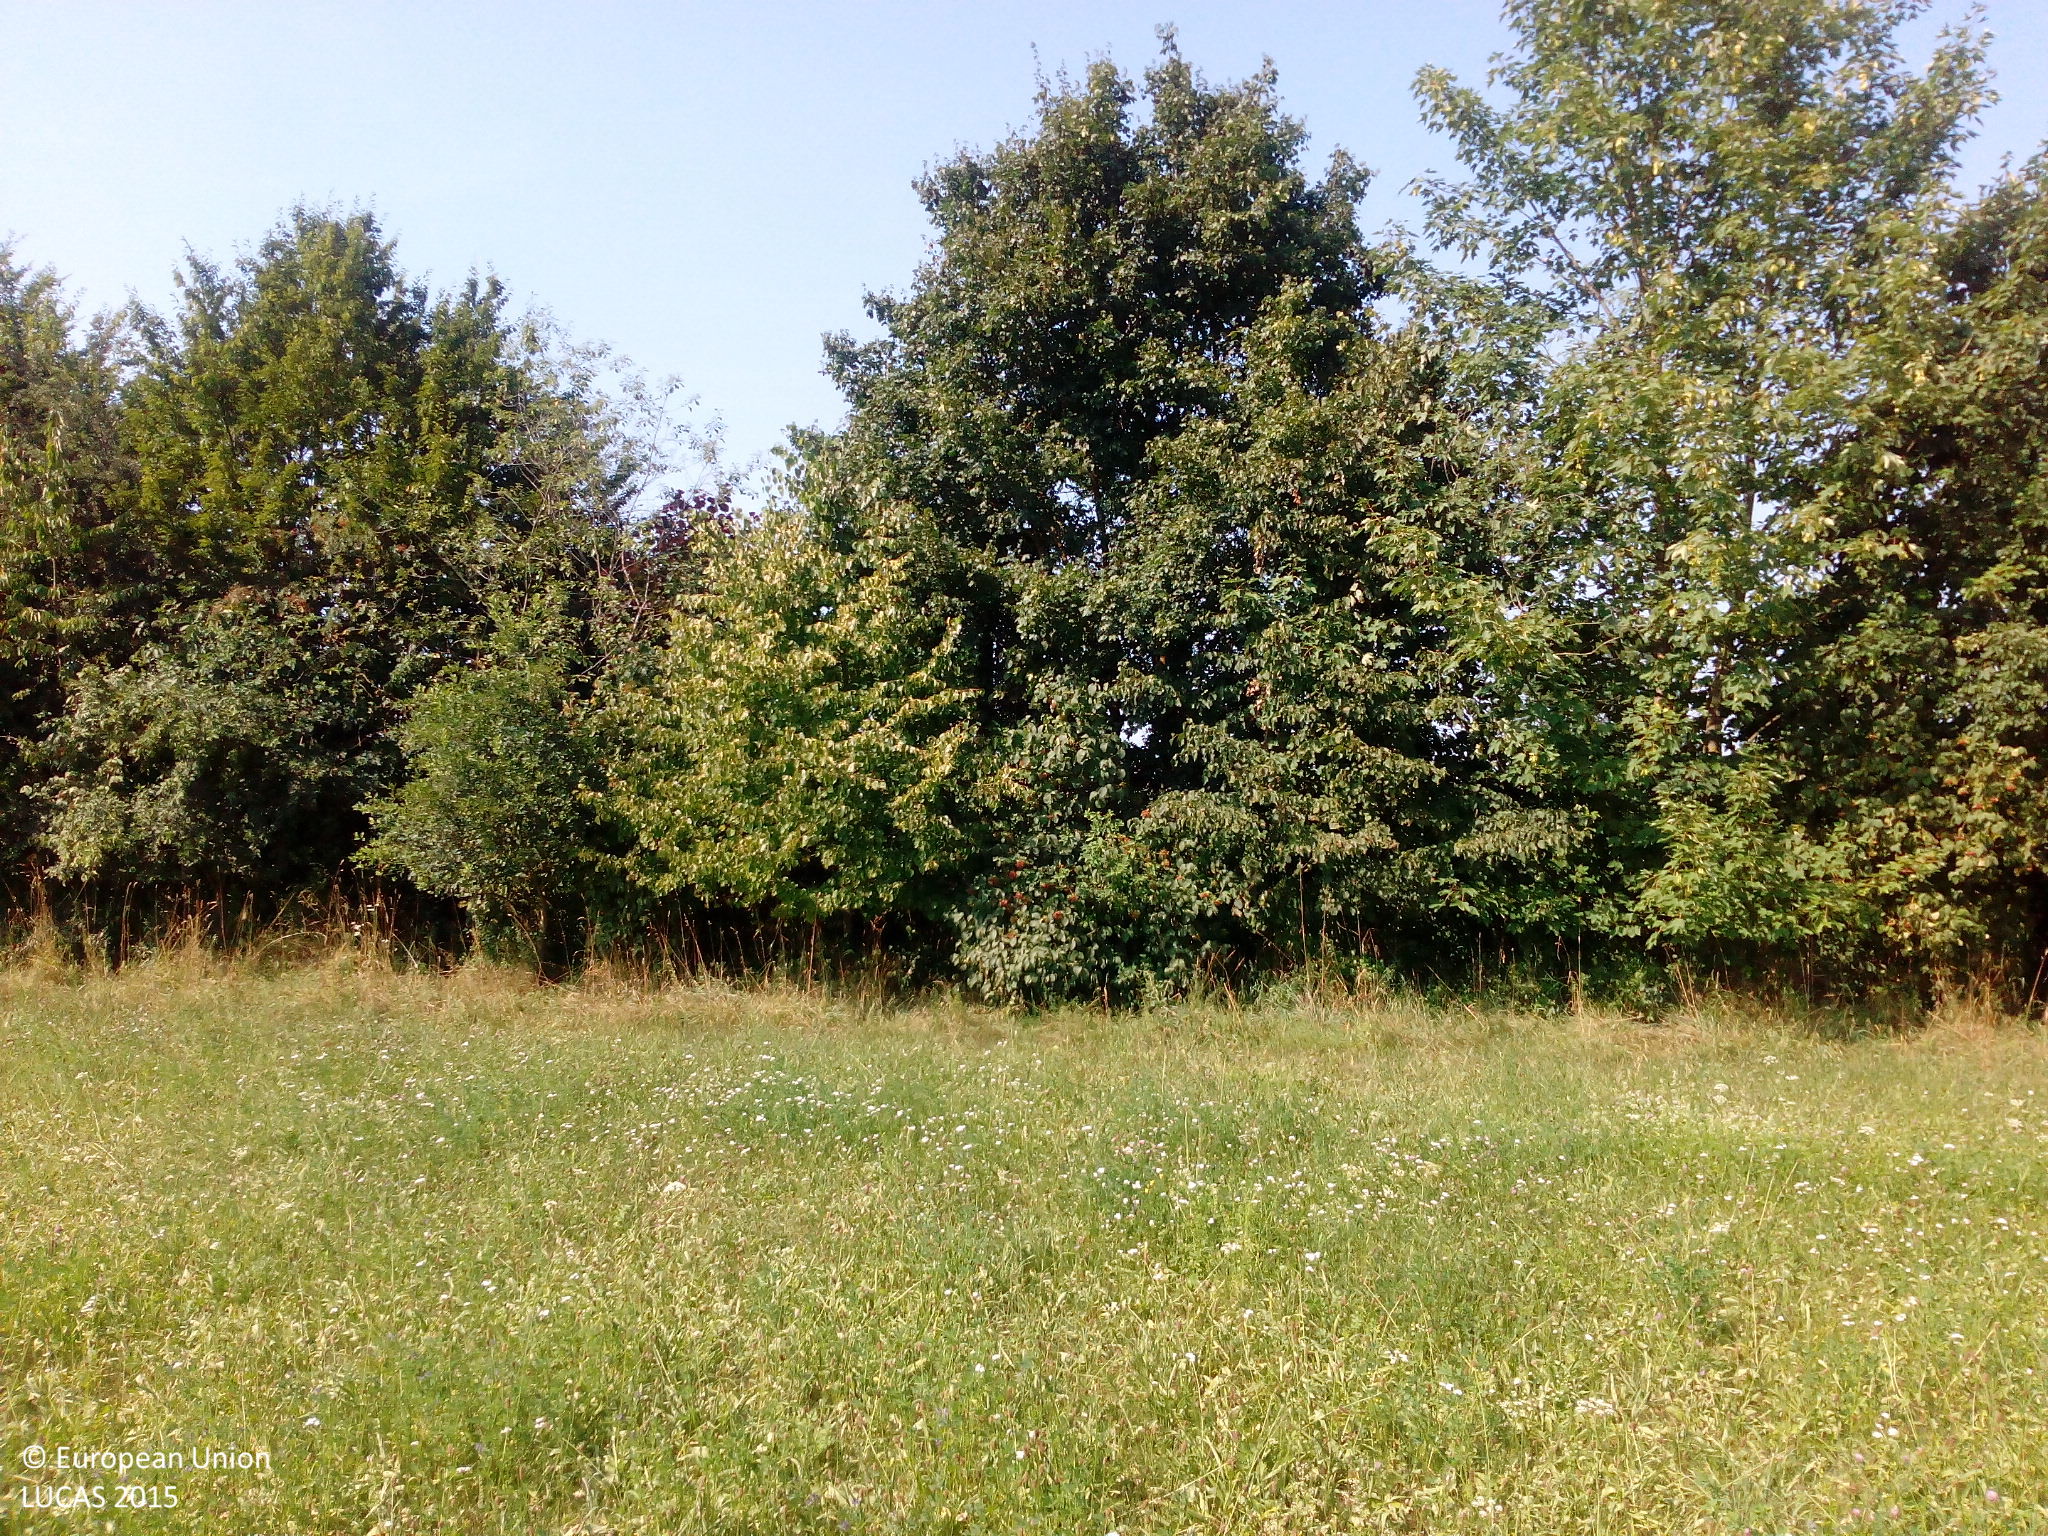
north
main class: Grassland
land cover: Grassland without tree/shrub cover
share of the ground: > 75 %
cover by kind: herbaceous plants 100 %
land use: Agriculture (excluding fallow land and kitchen gardens)
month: July
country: DE
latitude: 48.2237
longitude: 12.8123
